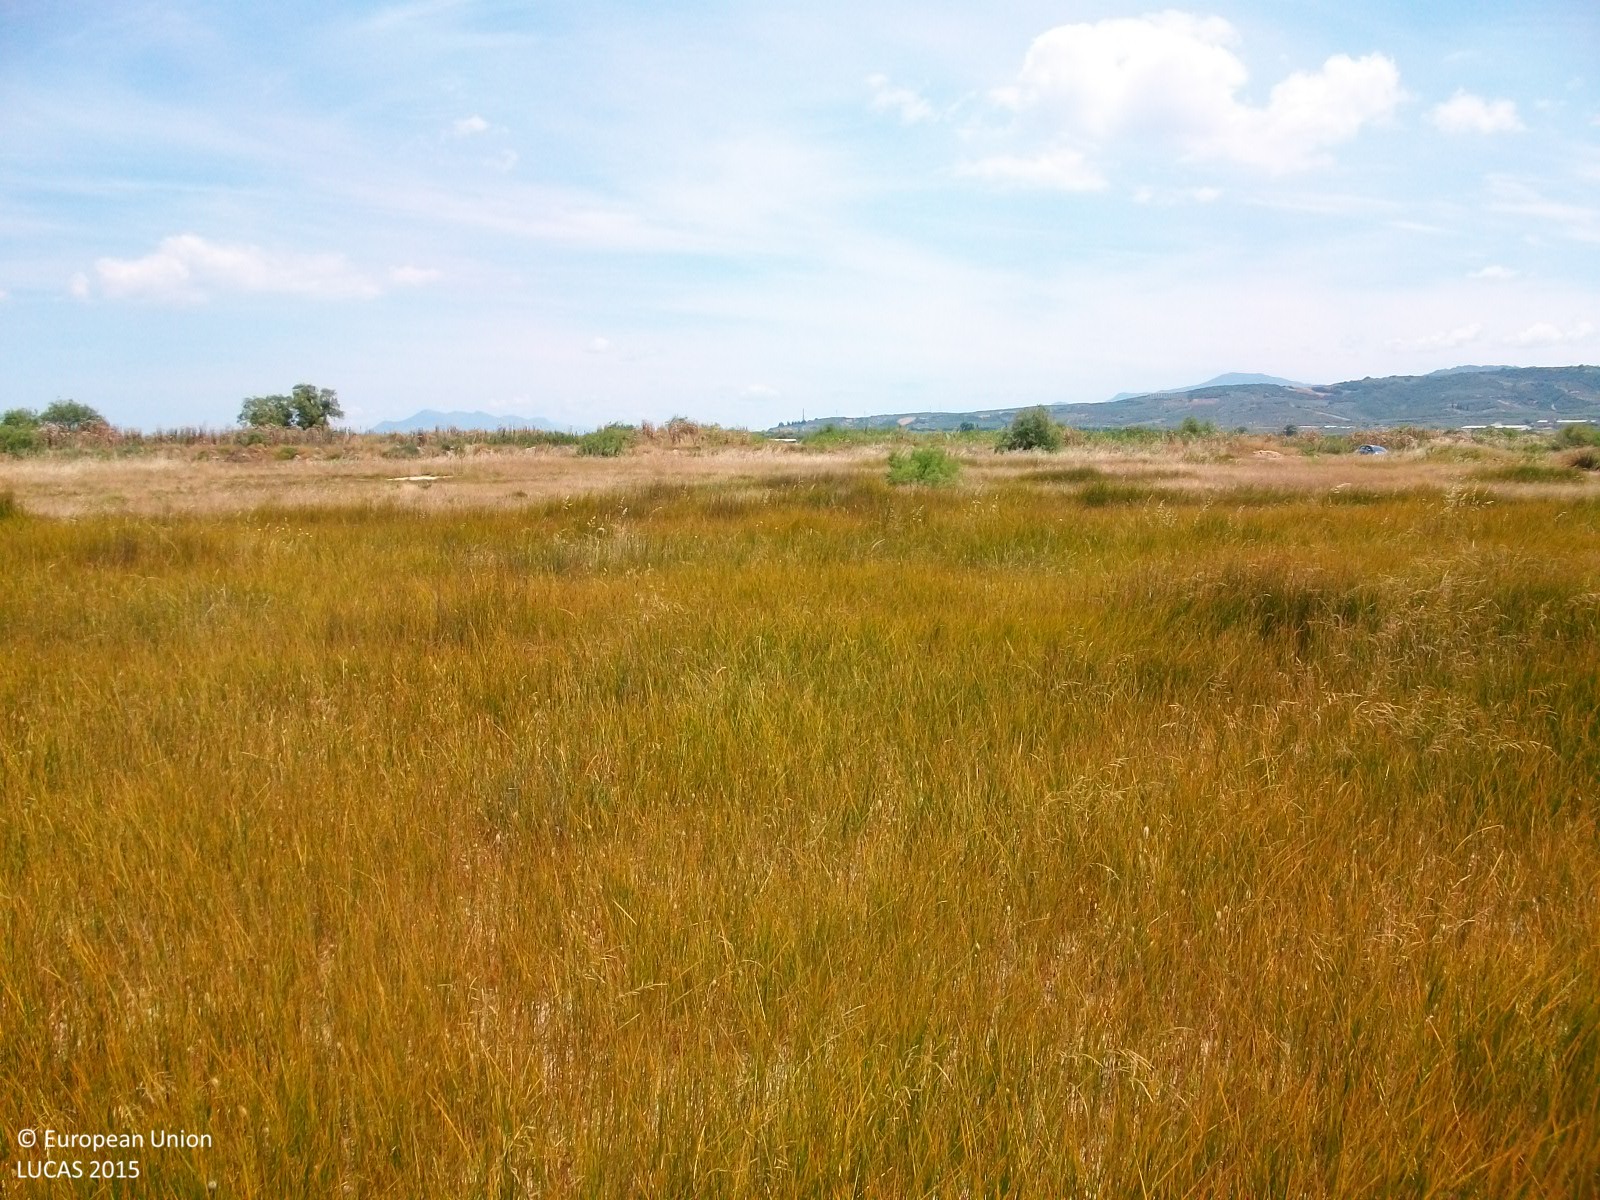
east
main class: Grassland
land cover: Spontaneously vegetated surfaces
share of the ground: > 75 %
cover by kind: herbaceous plants 100 %
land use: Fallow land
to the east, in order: Spontaneously vegetated surfaces; Tracks; Abandoned hedges; Rivers and streams; Shrubland without tree cover; Tracks; Spontaneously vegetated surfaces; Ditches and canals; Spontaneously vegetated surfaces
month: June
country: GR
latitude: 38.8152
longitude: 22.5686
